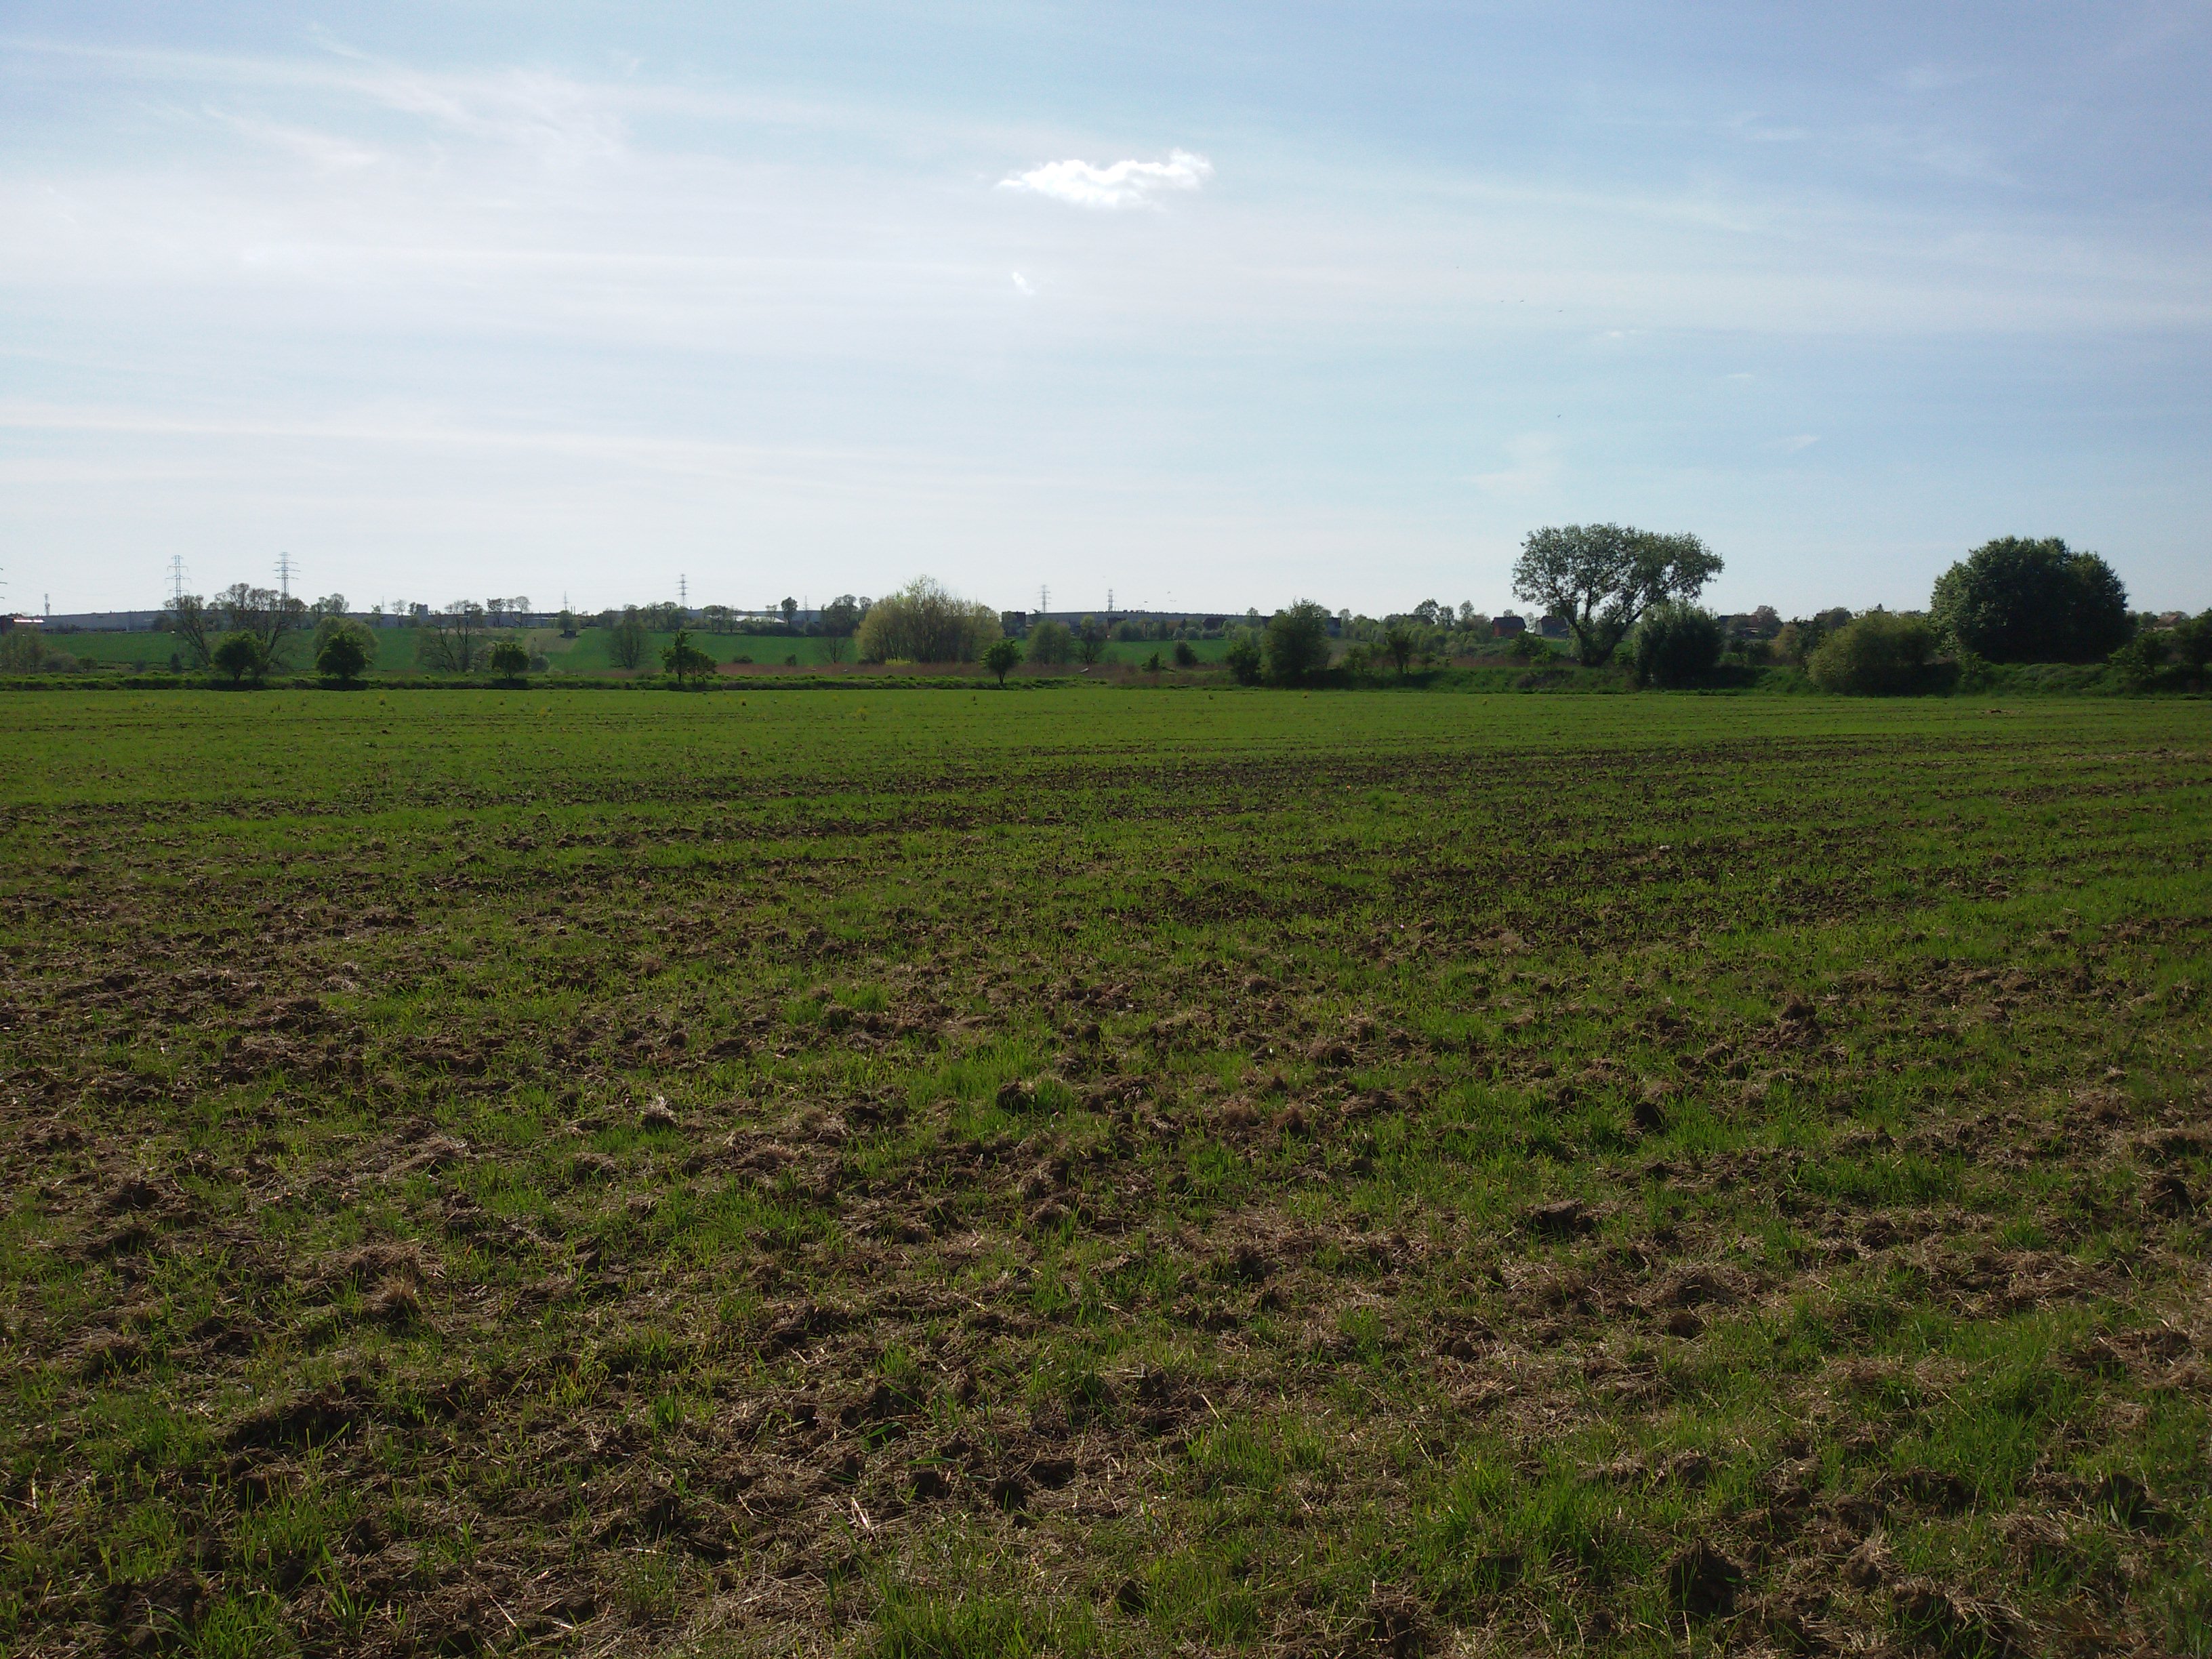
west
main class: Cropland
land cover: Temporary grasslands
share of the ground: > 75 %
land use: Agriculture (excluding fallow land and kitchen gardens)
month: May
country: PL
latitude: 50.3267
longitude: 18.6308
